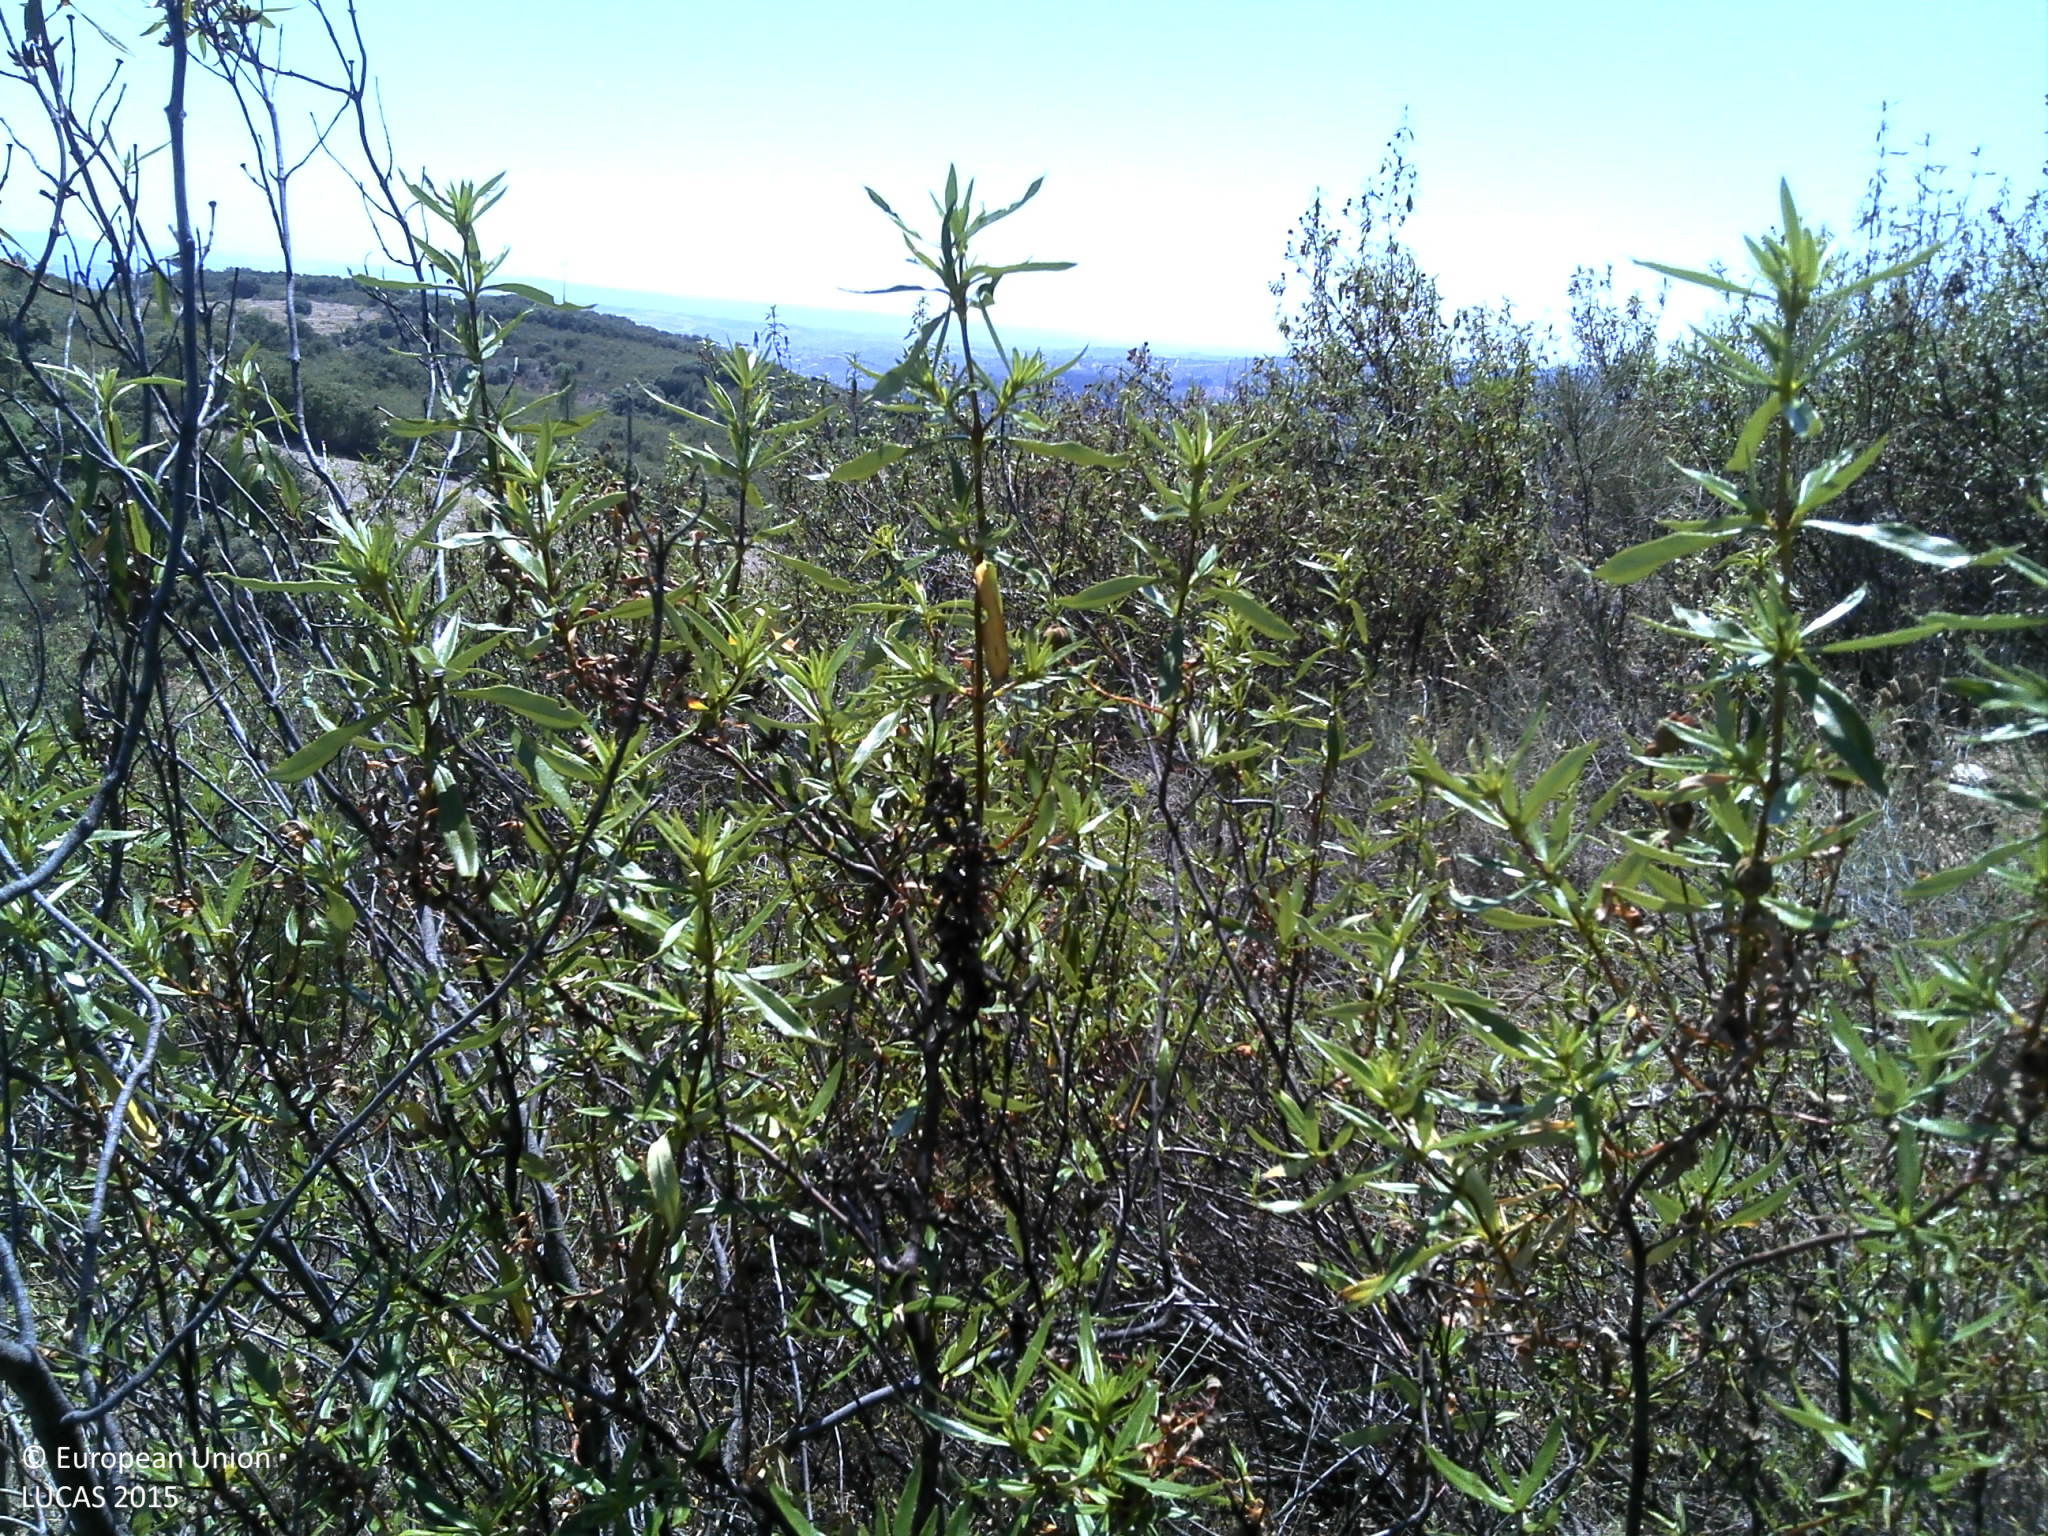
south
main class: Shrubland
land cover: Shrubland with sparse tree cover
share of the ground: > 75 %
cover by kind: shrubs 95 %, broadleaved forest trees 5 %
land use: Semi-natural and natural areas not in use
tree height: < 5 m
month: July
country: PT
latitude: 41.0178
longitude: -7.2247
